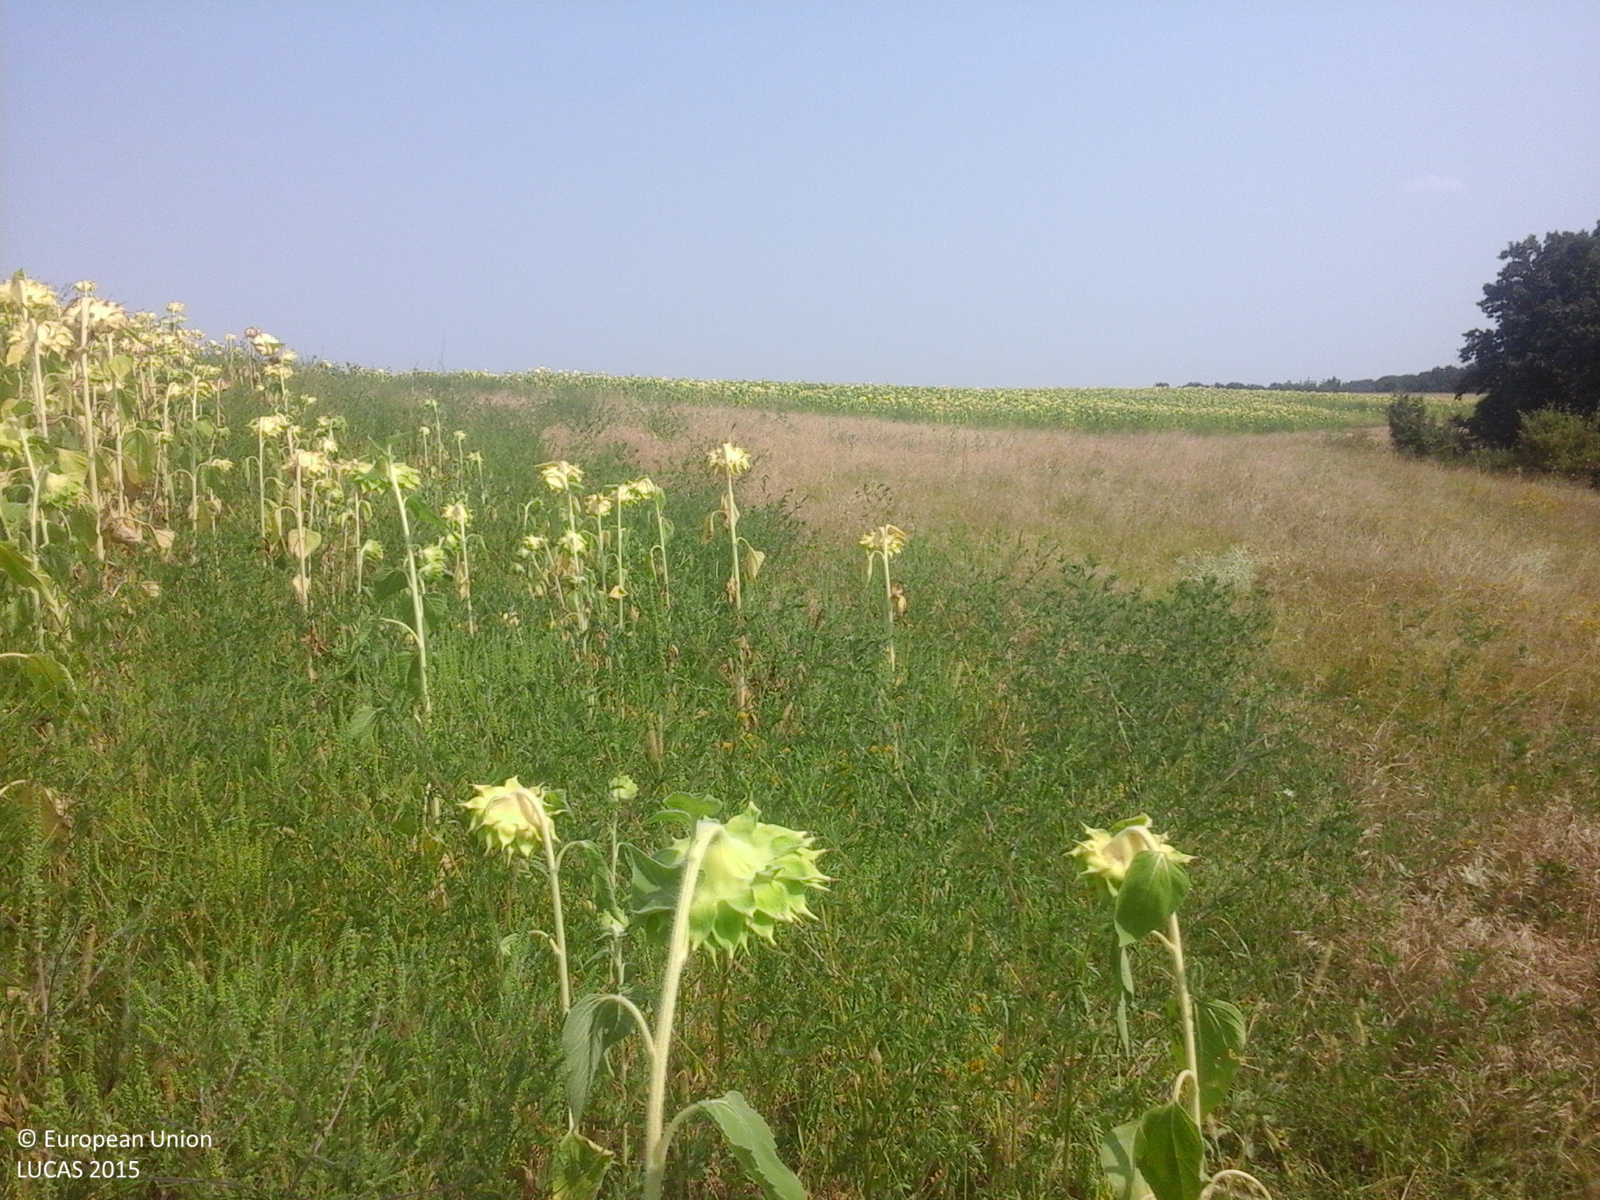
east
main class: Cropland
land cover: Sunflower
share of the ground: > 75 %
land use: Agriculture (excluding fallow land and kitchen gardens)
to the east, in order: Sunflower; Arable land (only in case pi); Grassland with sparse tree/shrub cover; Tracks; Broadleaved woodland; Tracks; Arable land (only in case pi); Sunflower
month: August
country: RO
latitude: 44.2179
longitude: 23.7357
